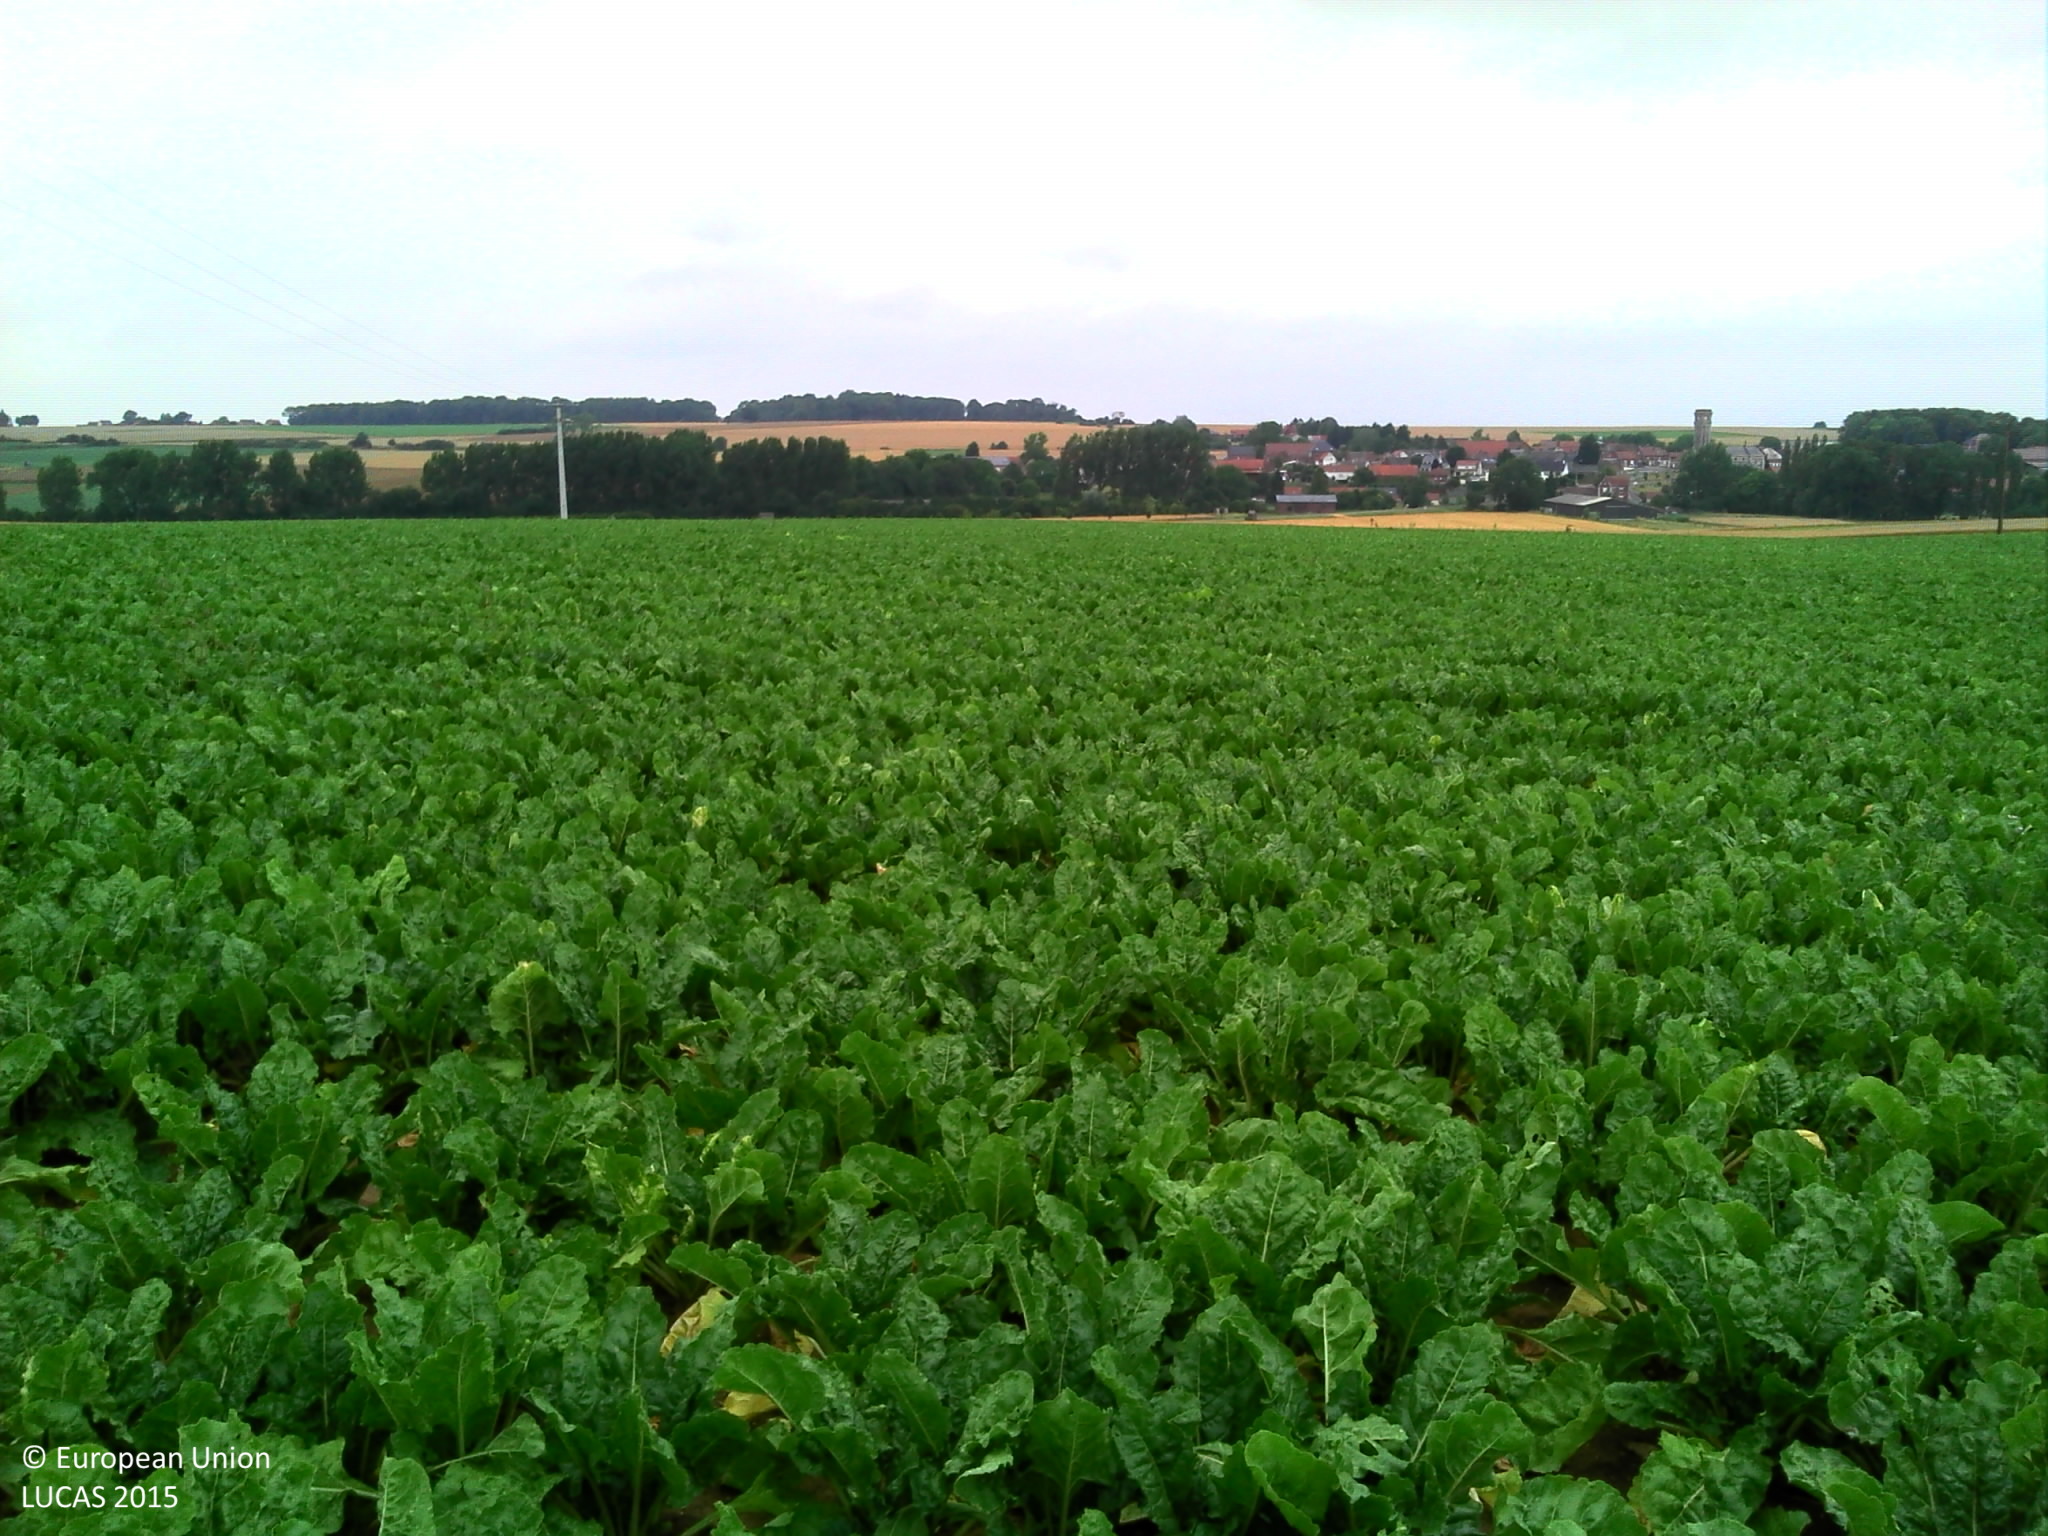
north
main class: Cropland
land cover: Sugar beet
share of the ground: > 75 %
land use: Agriculture (excluding fallow land and kitchen gardens)
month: July
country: FR
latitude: 50.1031
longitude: 3.1260
